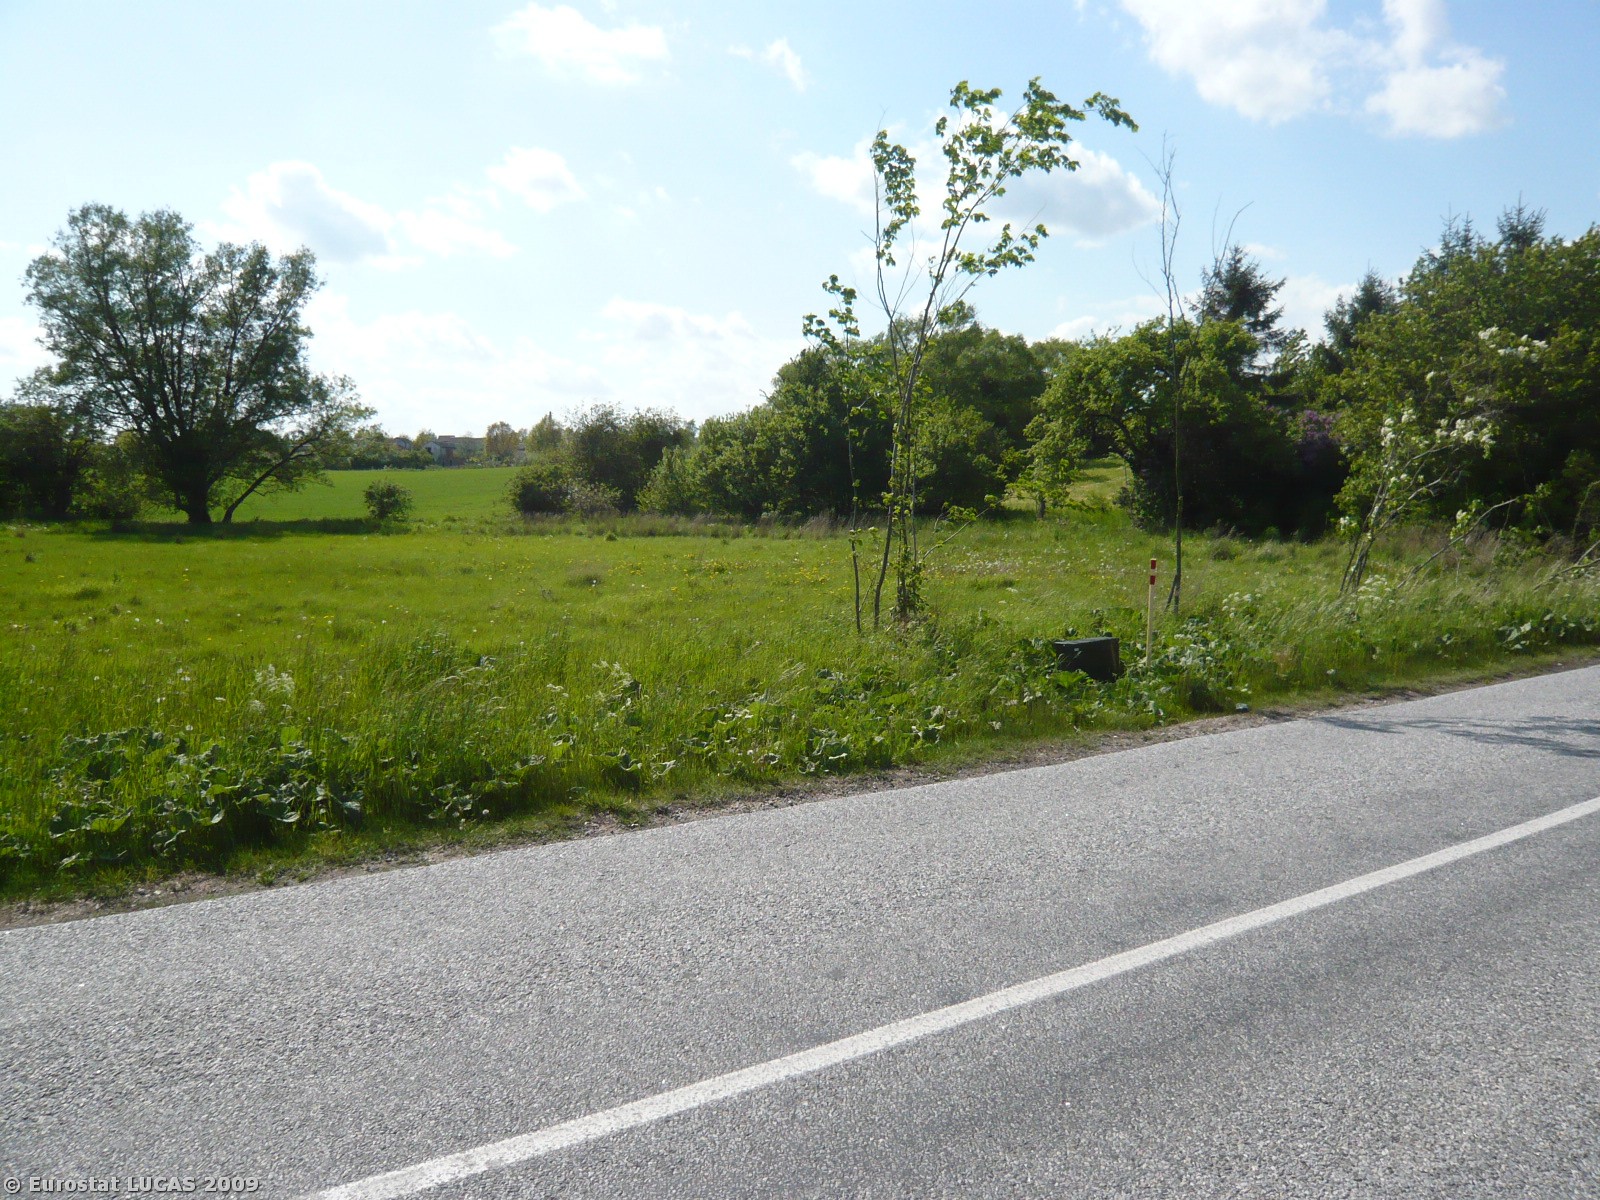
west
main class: Cropland
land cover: Common wheat
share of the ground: > 75 %
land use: Agriculture (excluding fallow land and kitchen gardens)
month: May
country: DK
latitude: 55.4143
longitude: 12.1624
